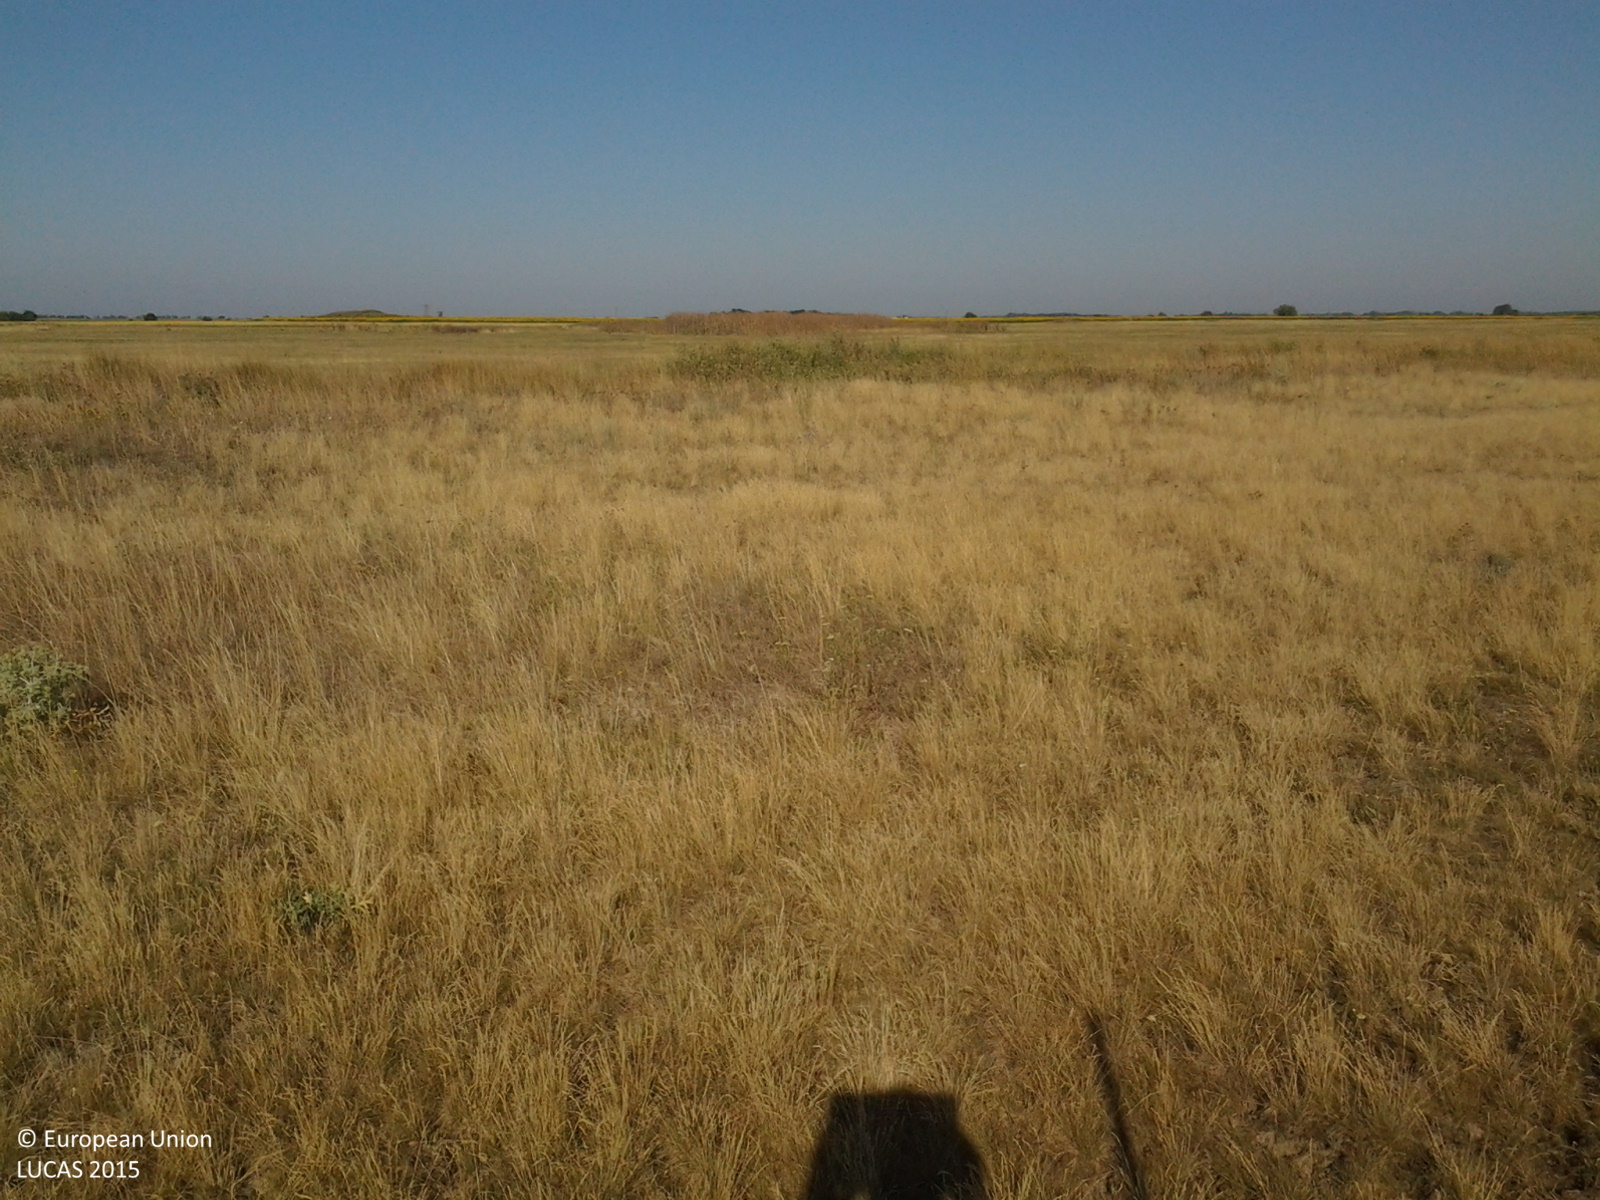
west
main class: Grassland
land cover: Grassland without tree/shrub cover
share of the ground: > 75 %
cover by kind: herbaceous plants 100 %
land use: Agriculture (excluding fallow land and kitchen gardens)
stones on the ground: < 10 %
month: July
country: HU
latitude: 47.0696
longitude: 20.8440
